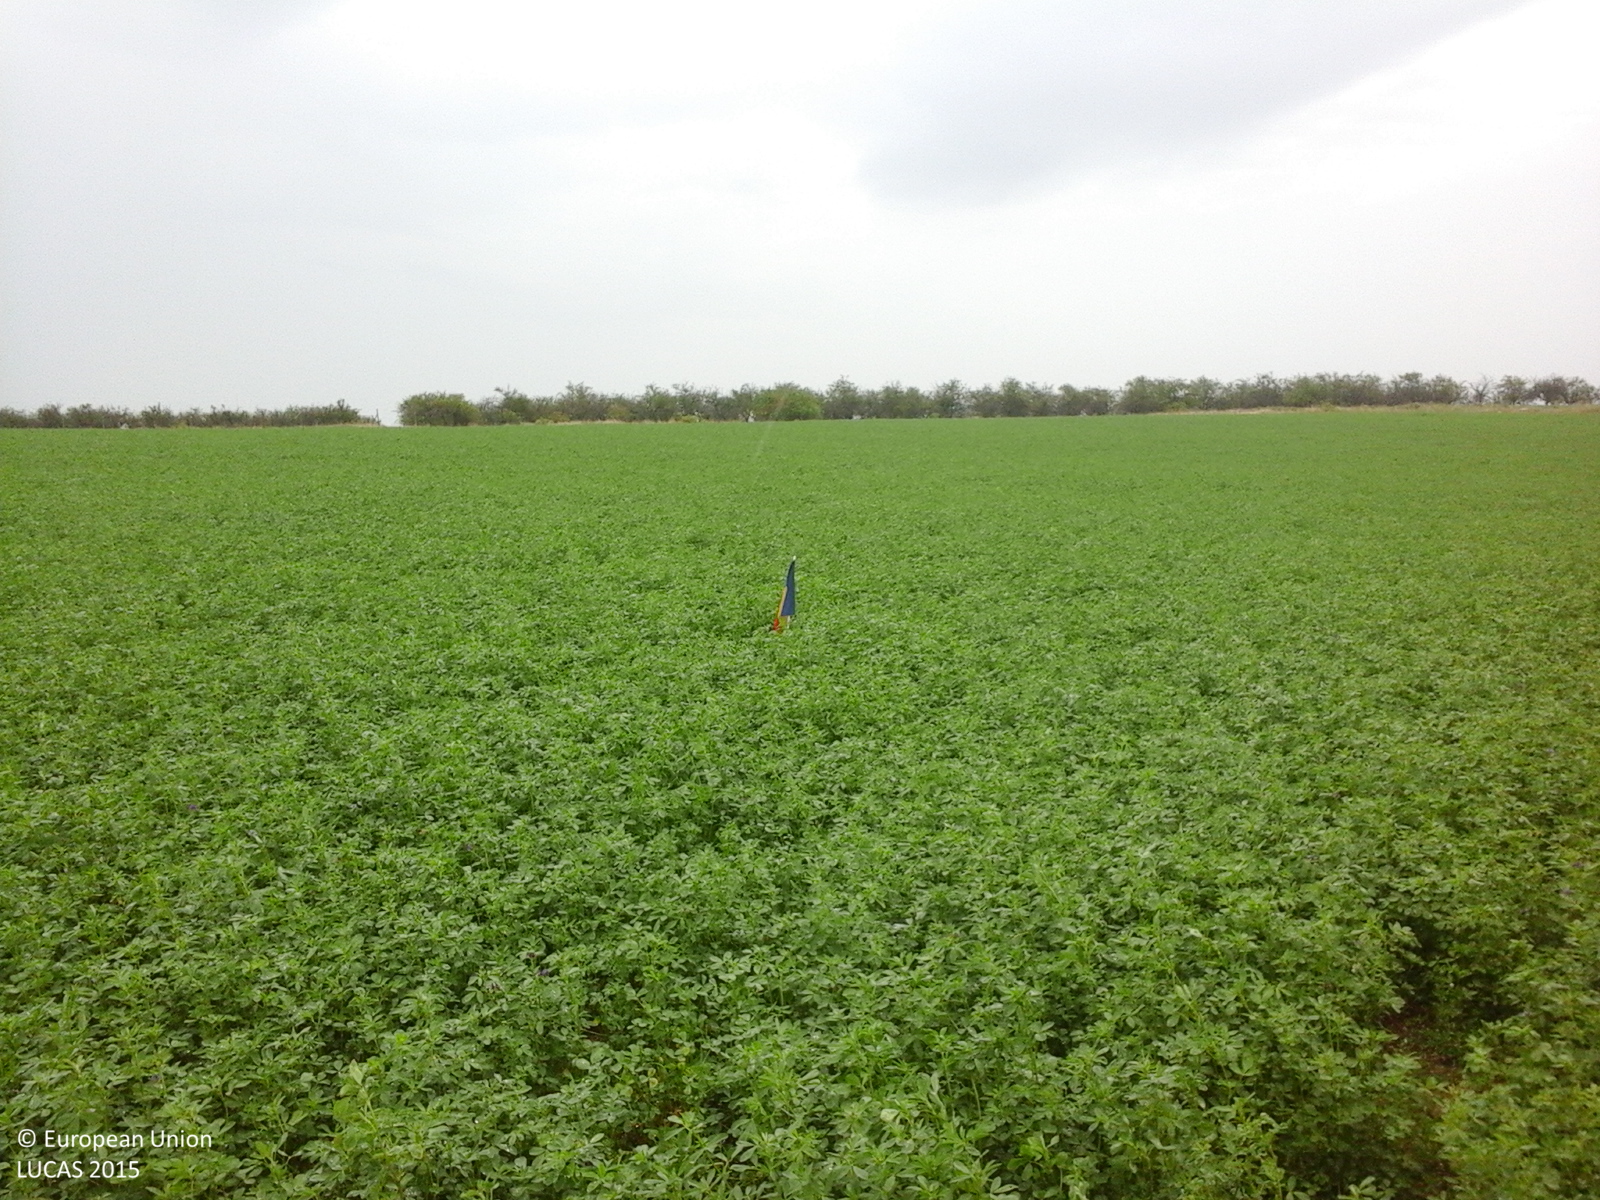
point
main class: Cropland
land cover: Lucerne
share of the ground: > 75 %
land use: Agriculture (excluding fallow land and kitchen gardens)
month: September
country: RO
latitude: 47.3409
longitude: 22.3764
